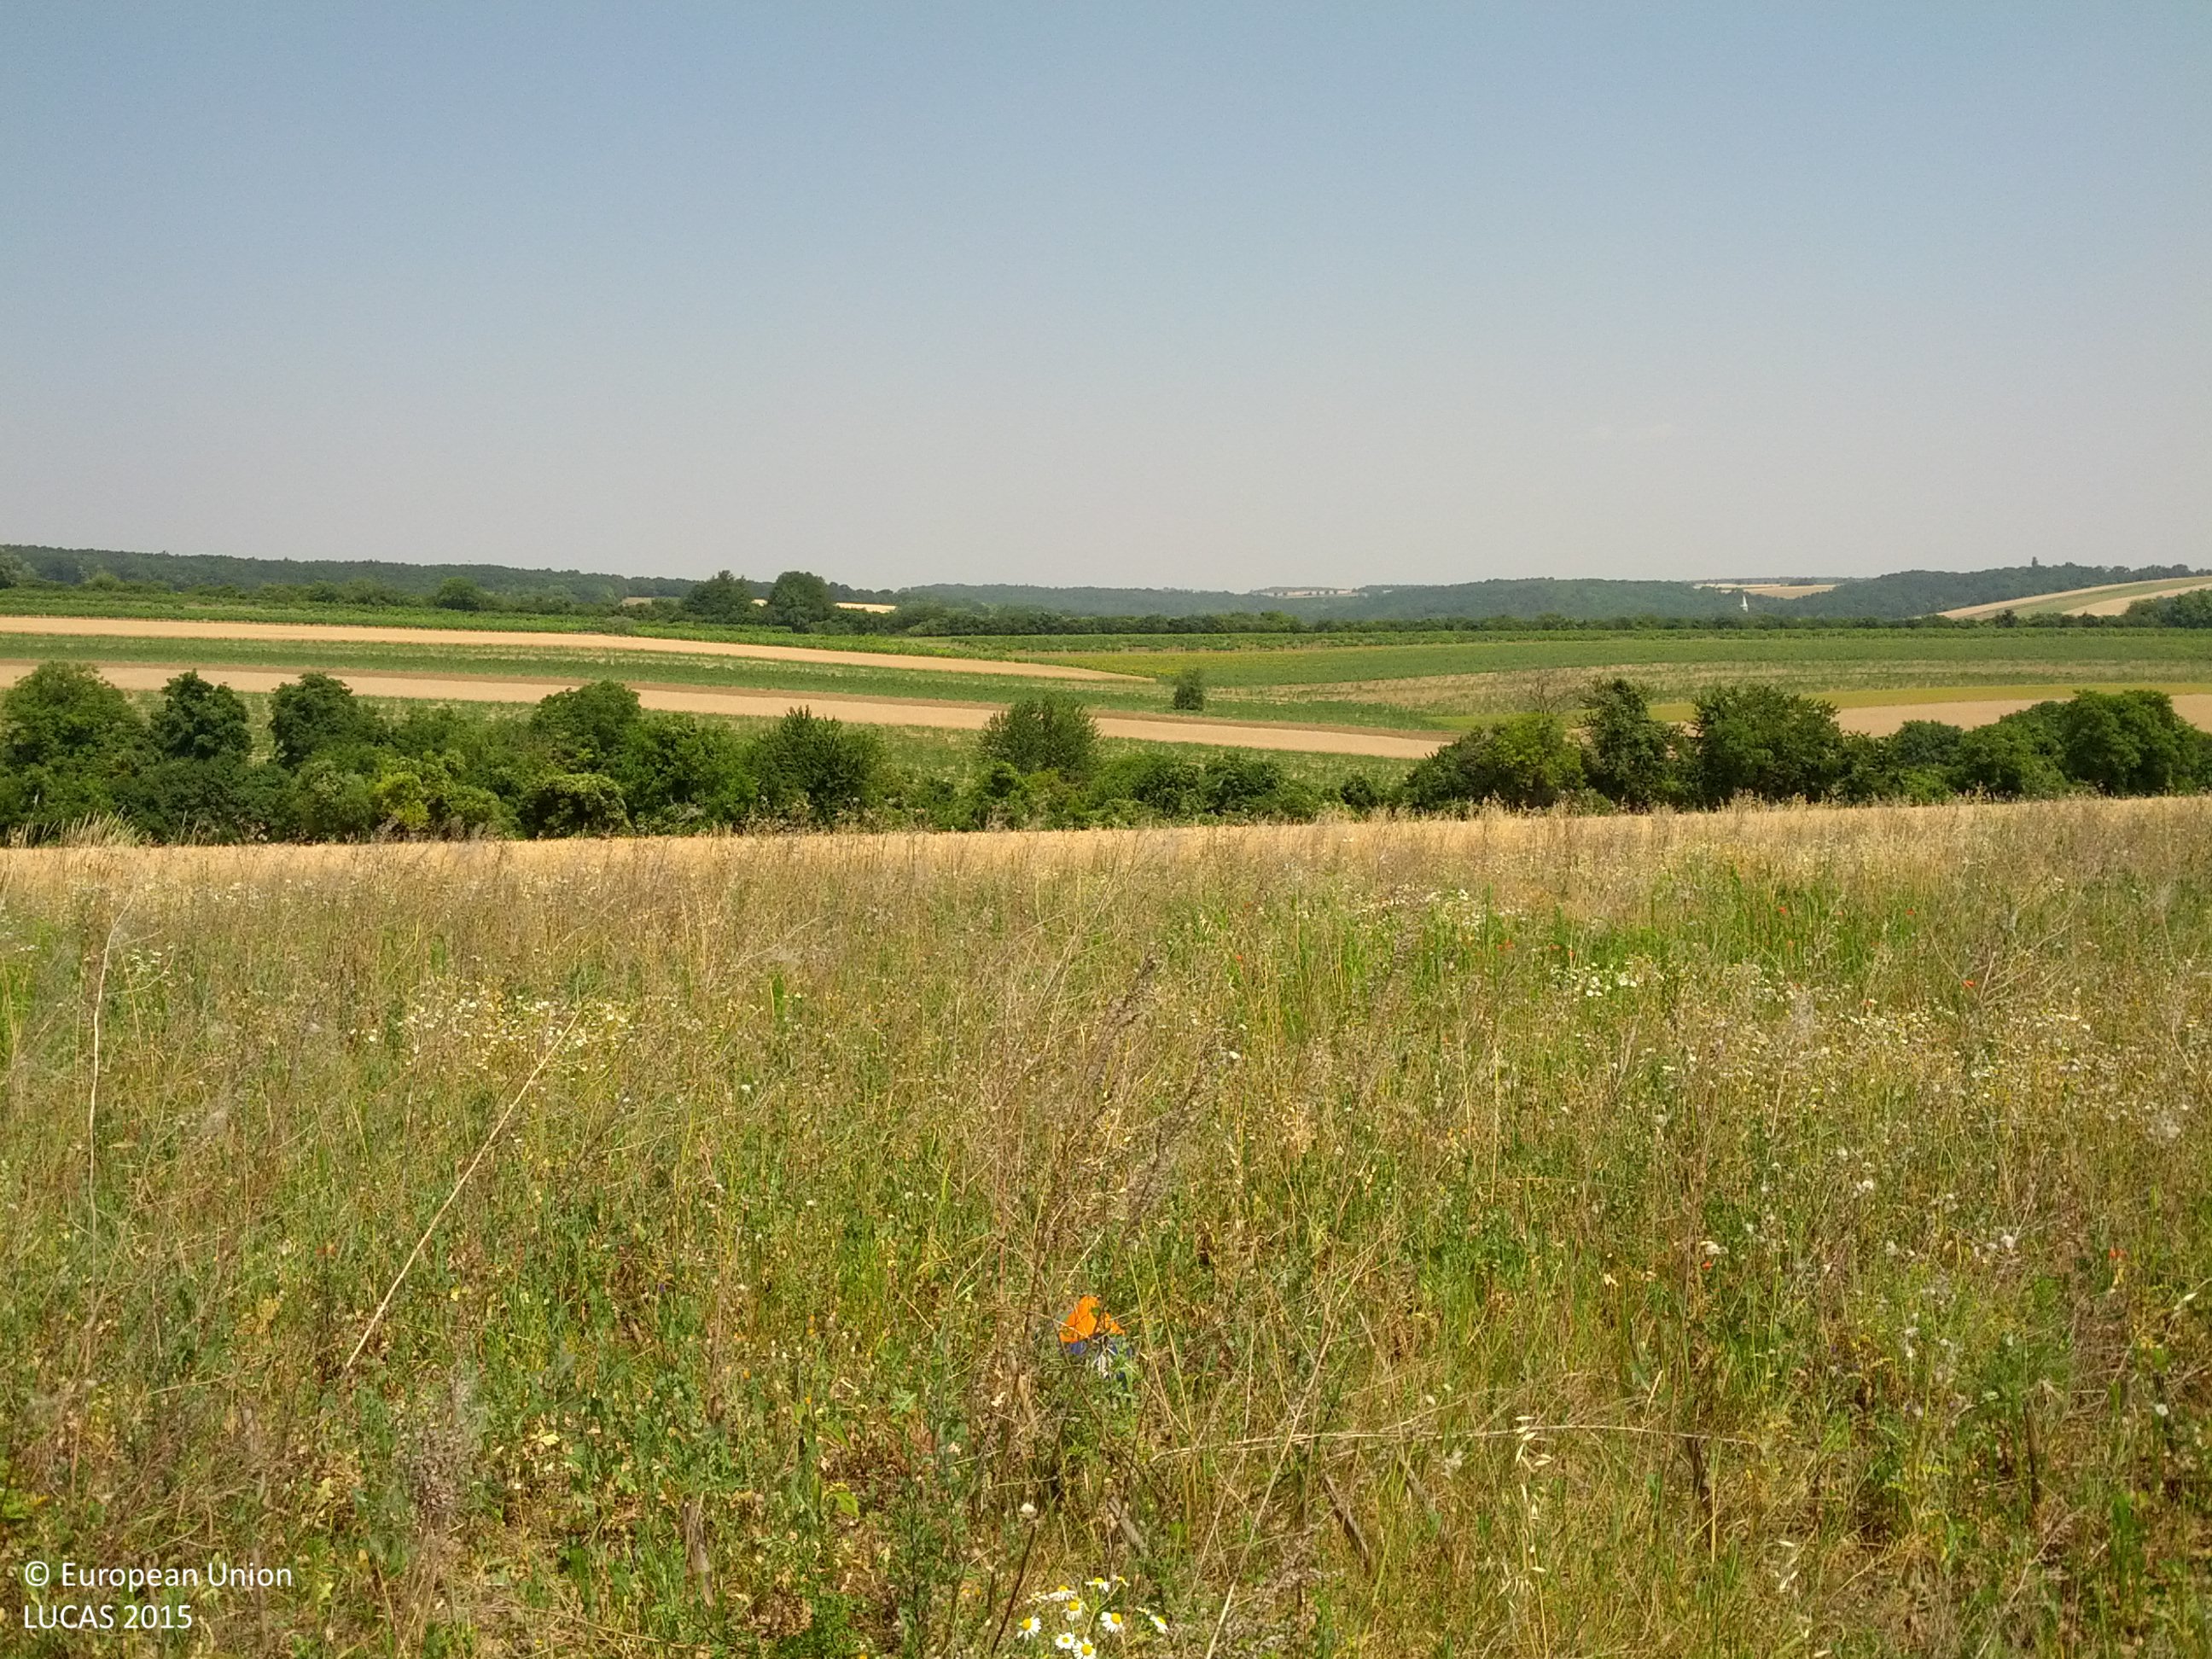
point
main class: Grassland
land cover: Spontaneously vegetated surfaces
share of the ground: > 75 %
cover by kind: herbaceous plants 100 %
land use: Fallow land
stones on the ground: < 10 %
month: July
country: AT
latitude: 48.4479
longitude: 16.4819
